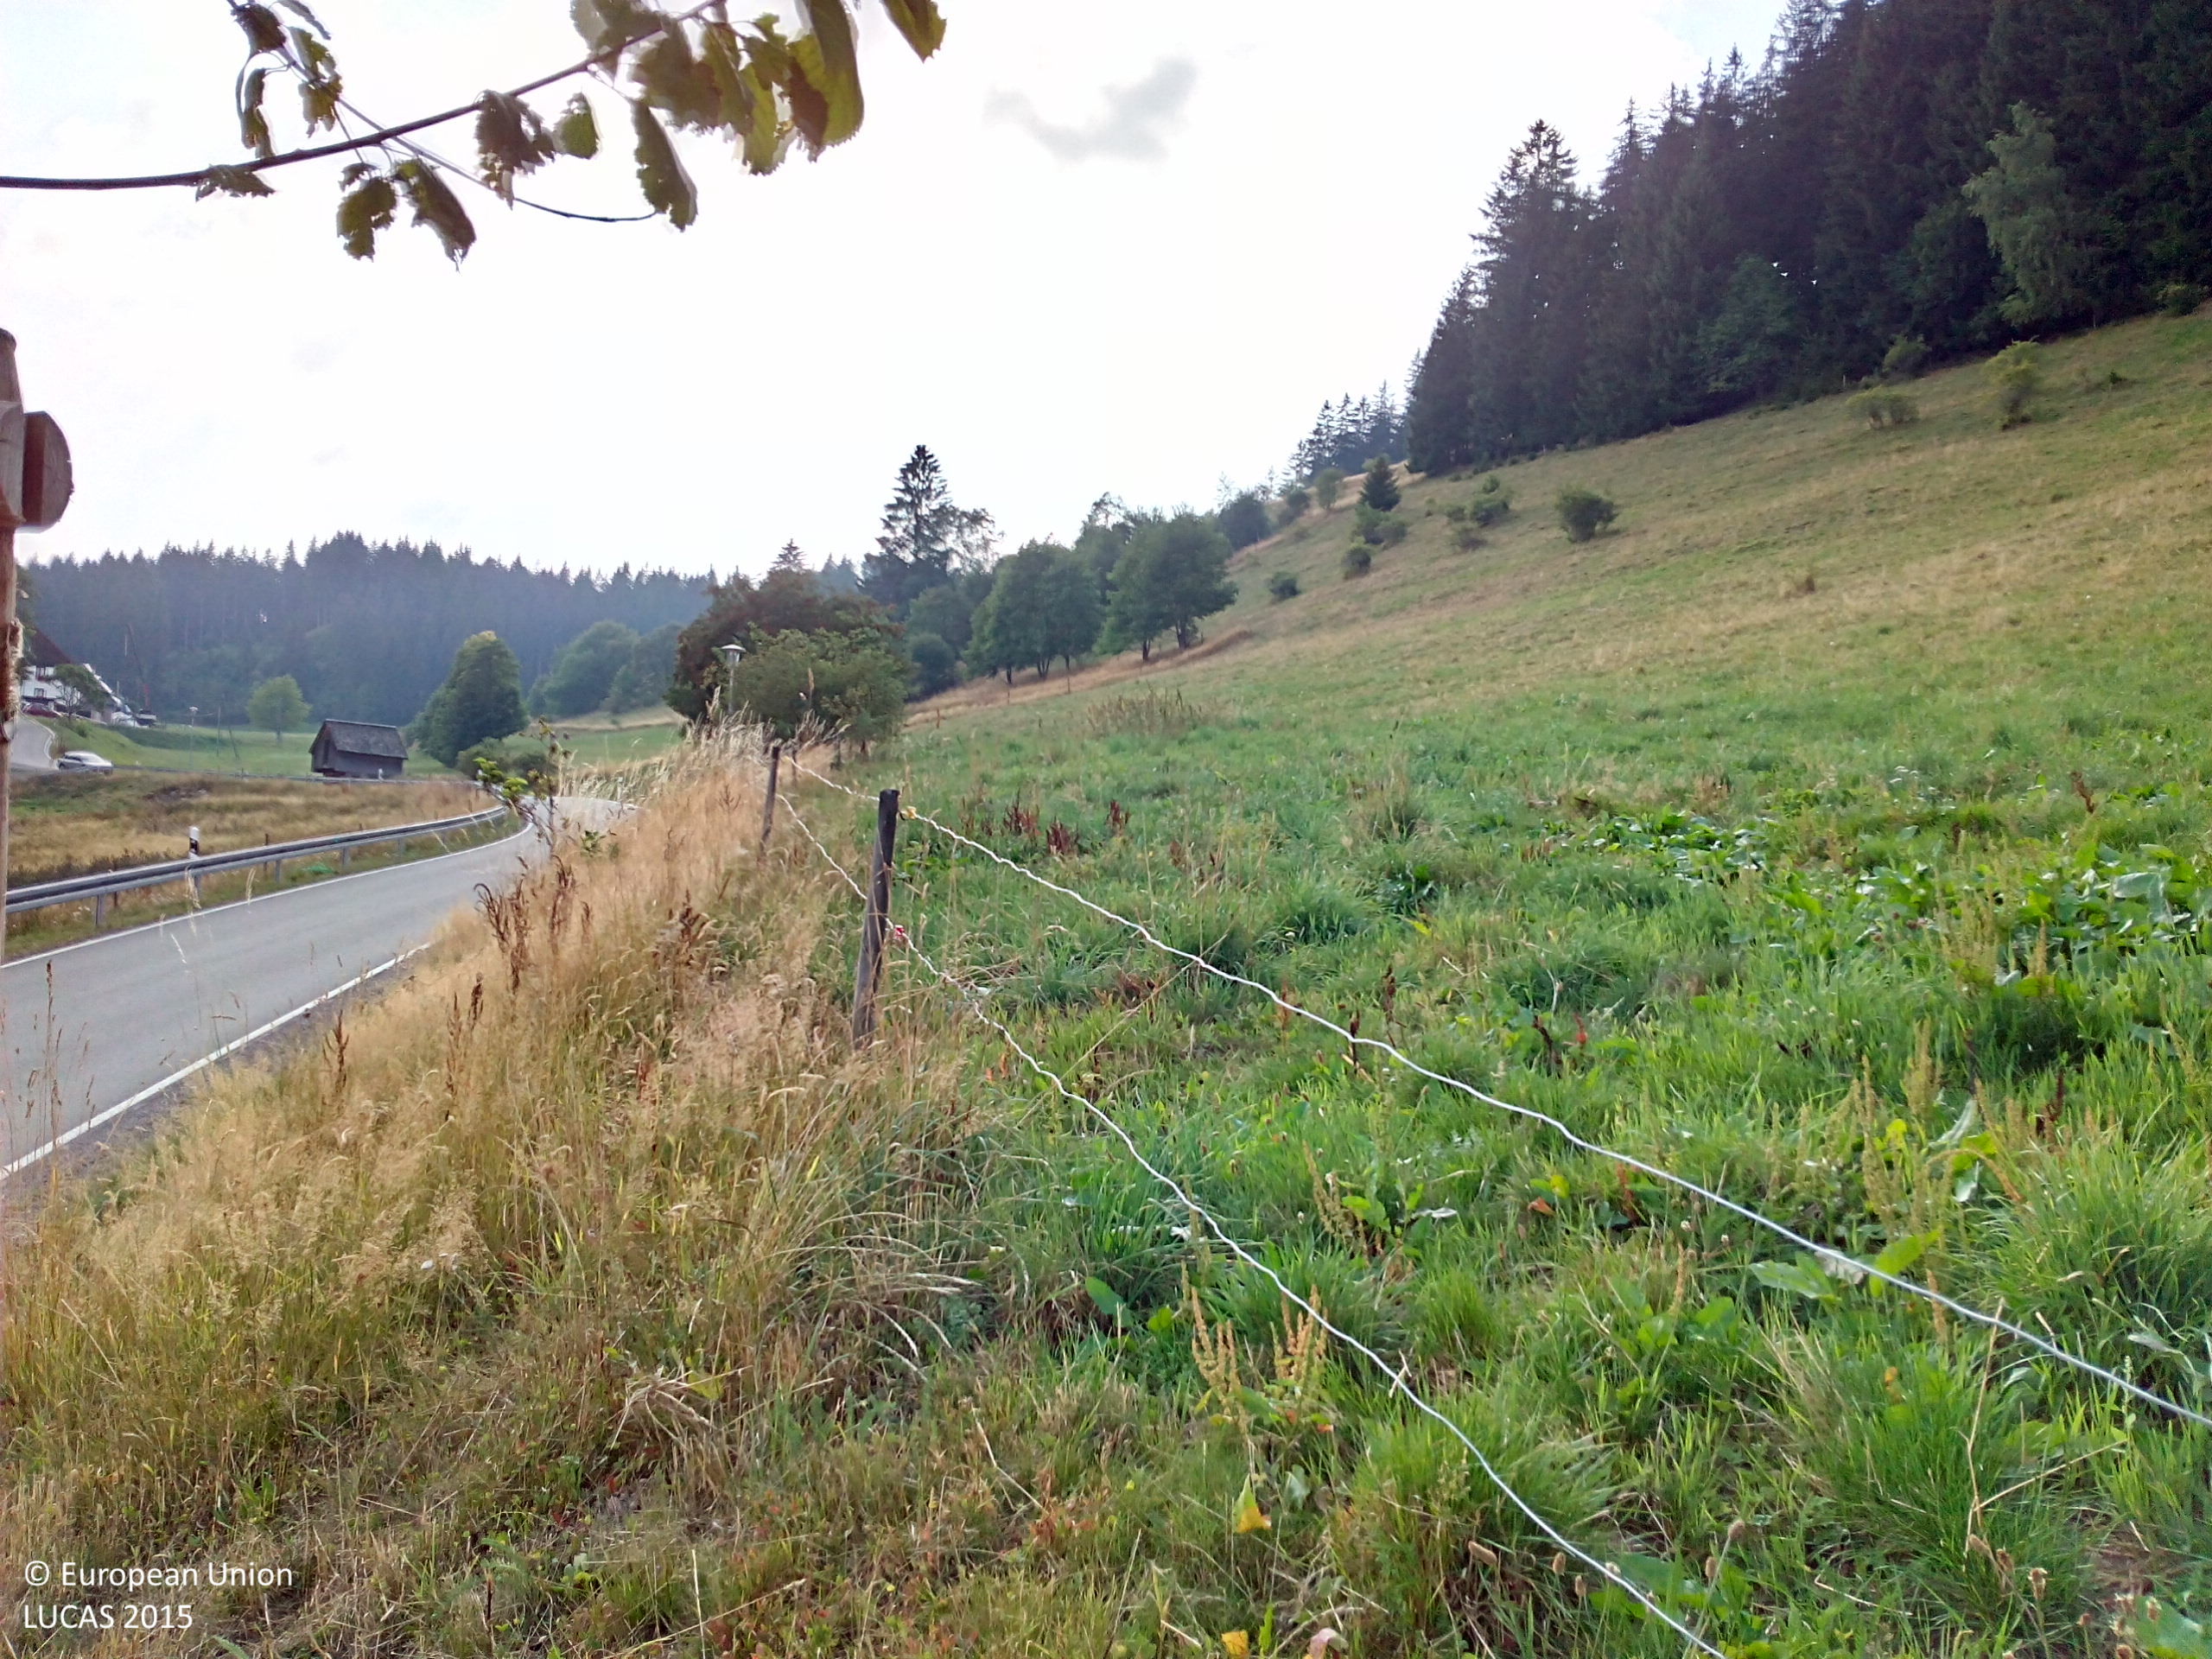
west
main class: Grassland
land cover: Grassland without tree/shrub cover
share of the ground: > 75 %
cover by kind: herbaceous plants 100 %
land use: Agriculture (excluding fallow land and kitchen gardens)
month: August
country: DE
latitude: 47.8659
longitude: 8.1430
